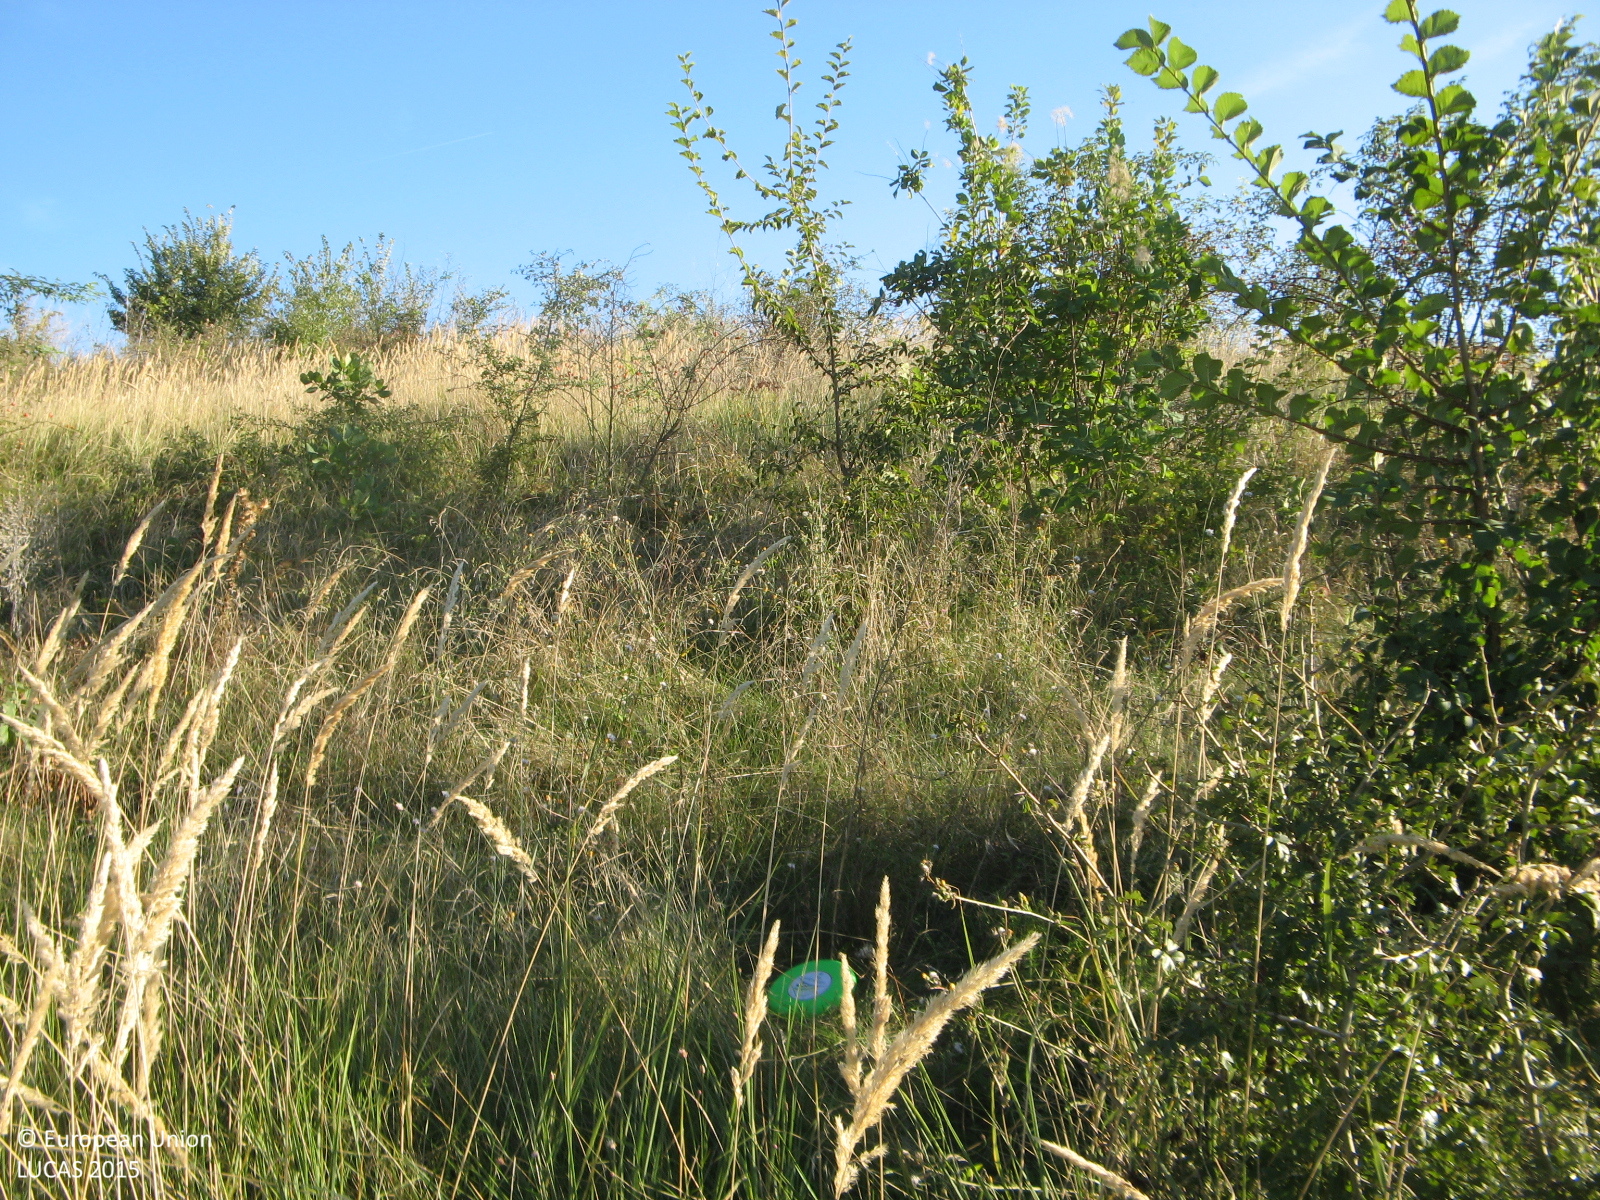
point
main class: Grassland
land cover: Grassland with sparse tree/shrub cover
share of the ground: > 75 %
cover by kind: herbaceous plants 90 %, broadleaved forest trees 5 %, shrubs 5 %
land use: Semi-natural and natural areas not in use
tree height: < 5 m
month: September
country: BG
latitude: 43.6096
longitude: 25.4324
